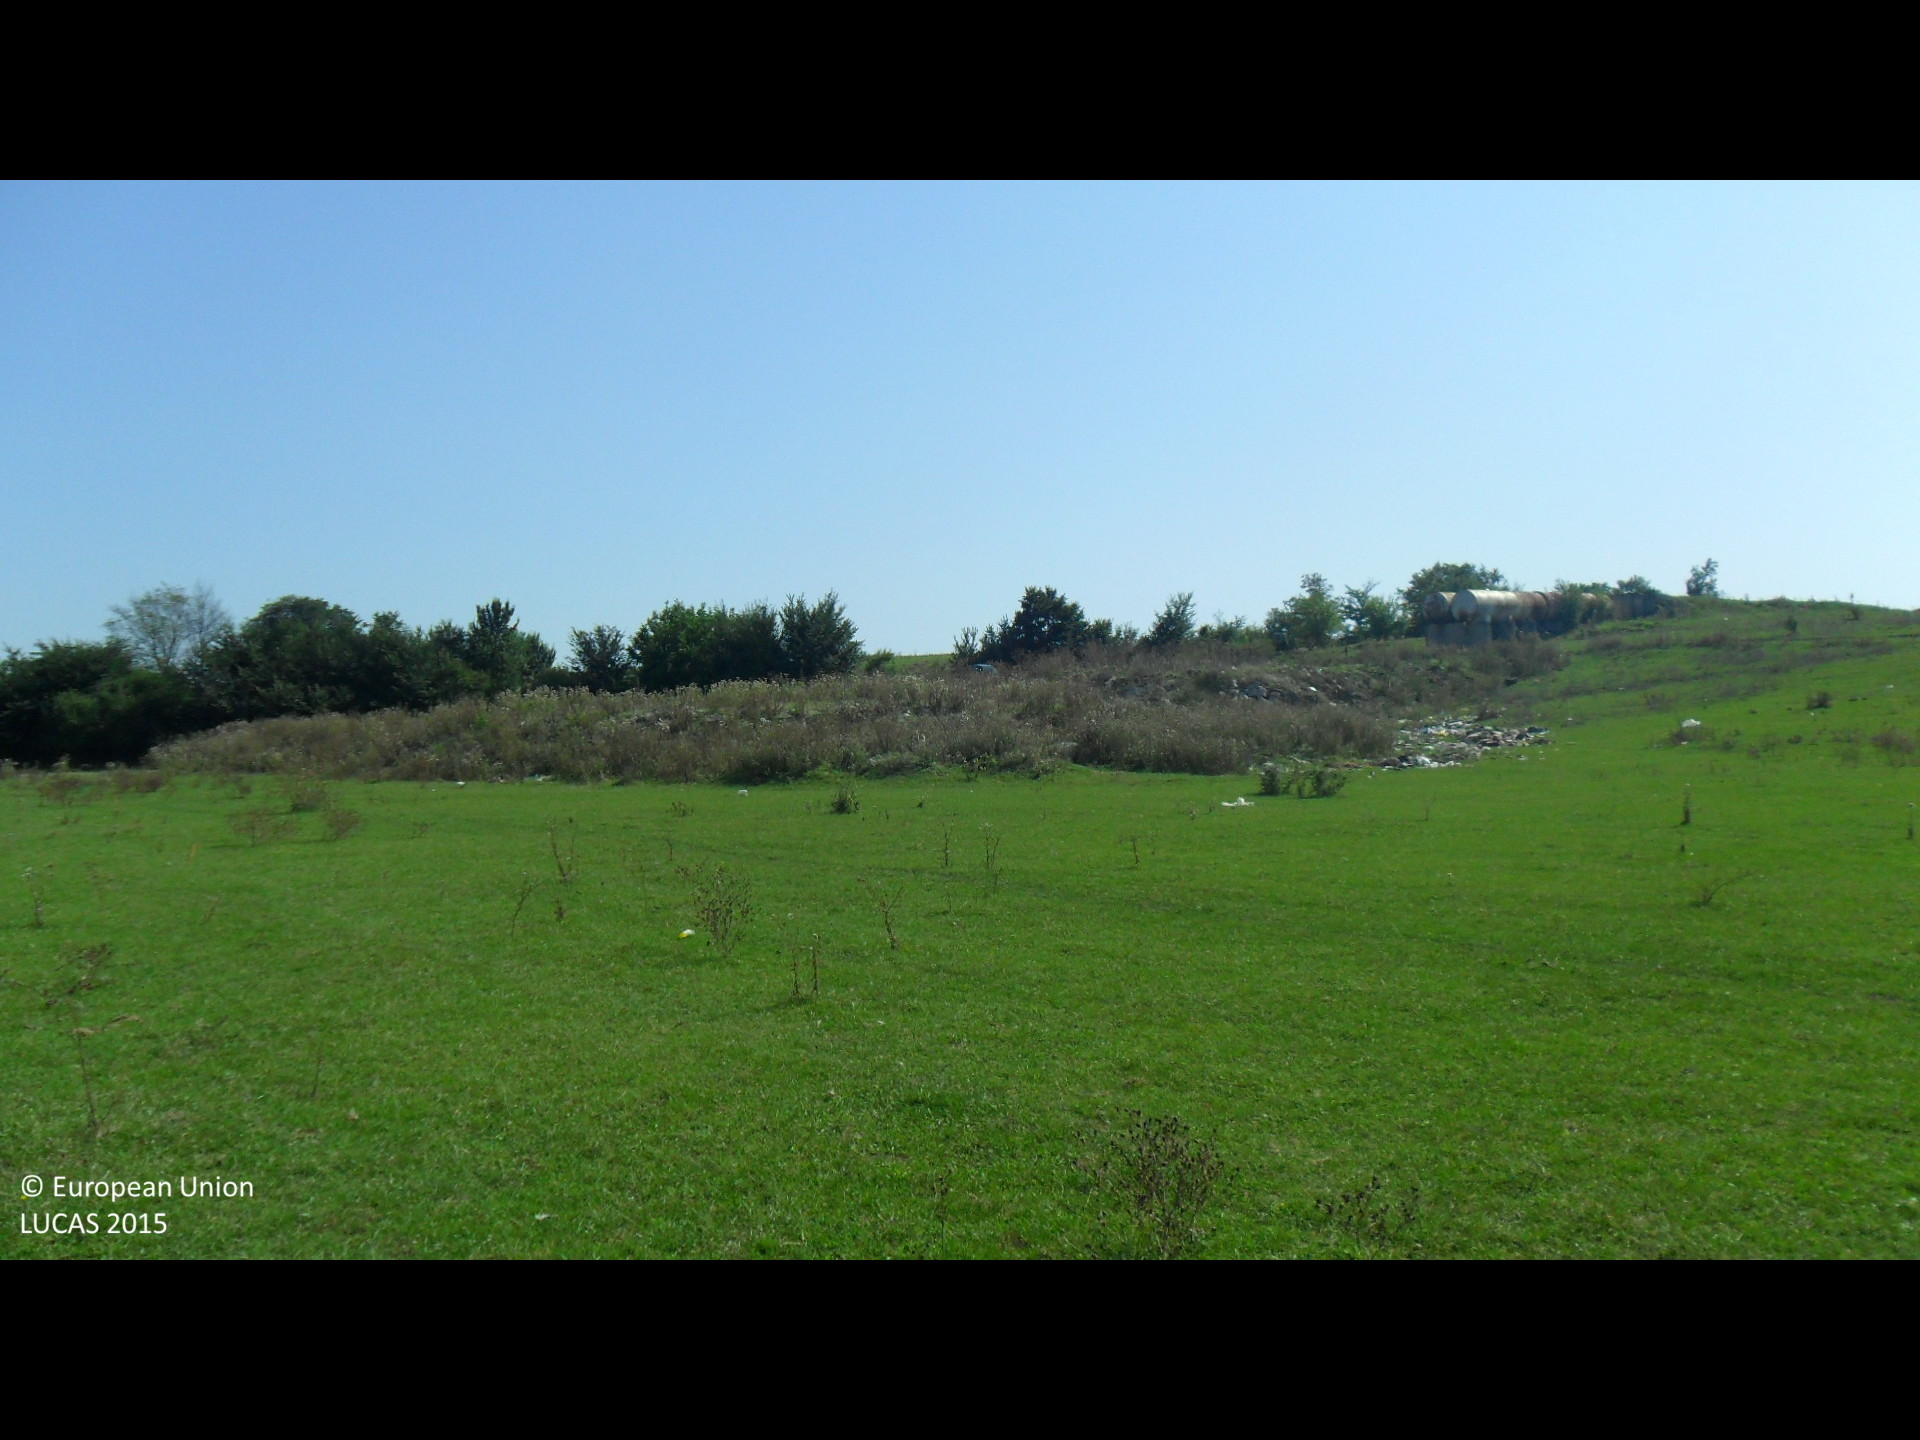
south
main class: Grassland
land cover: Grassland without tree/shrub cover
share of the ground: > 75 %
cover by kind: herbaceous plants 100 %
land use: Agriculture (excluding fallow land and kitchen gardens)
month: August
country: BG
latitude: 43.2733
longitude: 26.6282
